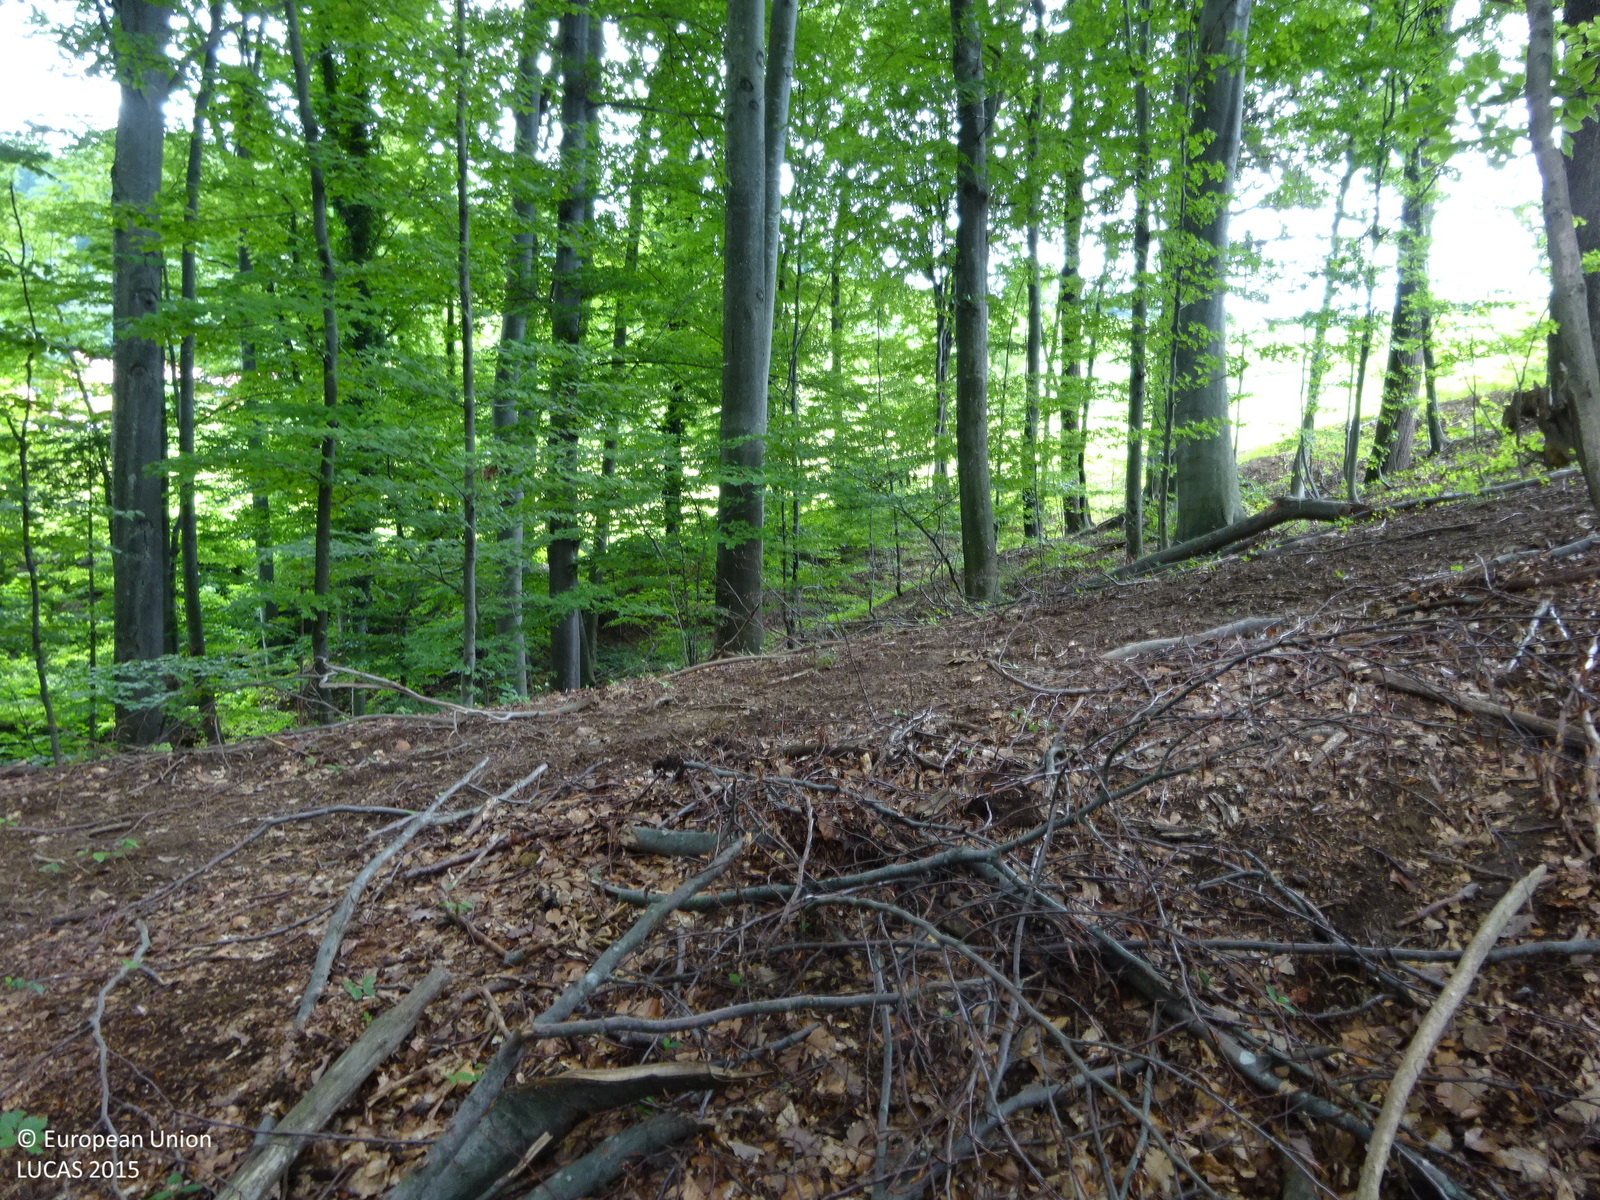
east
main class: Woodland
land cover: Broadleaved woodland
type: mountainous beech forest
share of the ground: > 75 %
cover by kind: broadleaved forest trees 90 %, unconsolidated bare surface 10 %
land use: Forestry
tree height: > 5 m
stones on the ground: < 10 %
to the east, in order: Broadleaved woodland; Grassland without tree/shrub cover; Electric lines; Grassland without tree/shrub cover; Lines of trees; Grass margins; Electric lines; Paved roads, cycling and walking lanes; Vineyards; Tracks; Vineyards; Fences; Shrubland with sparse tree cover
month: June
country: AT
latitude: 46.6941
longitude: 15.5569
